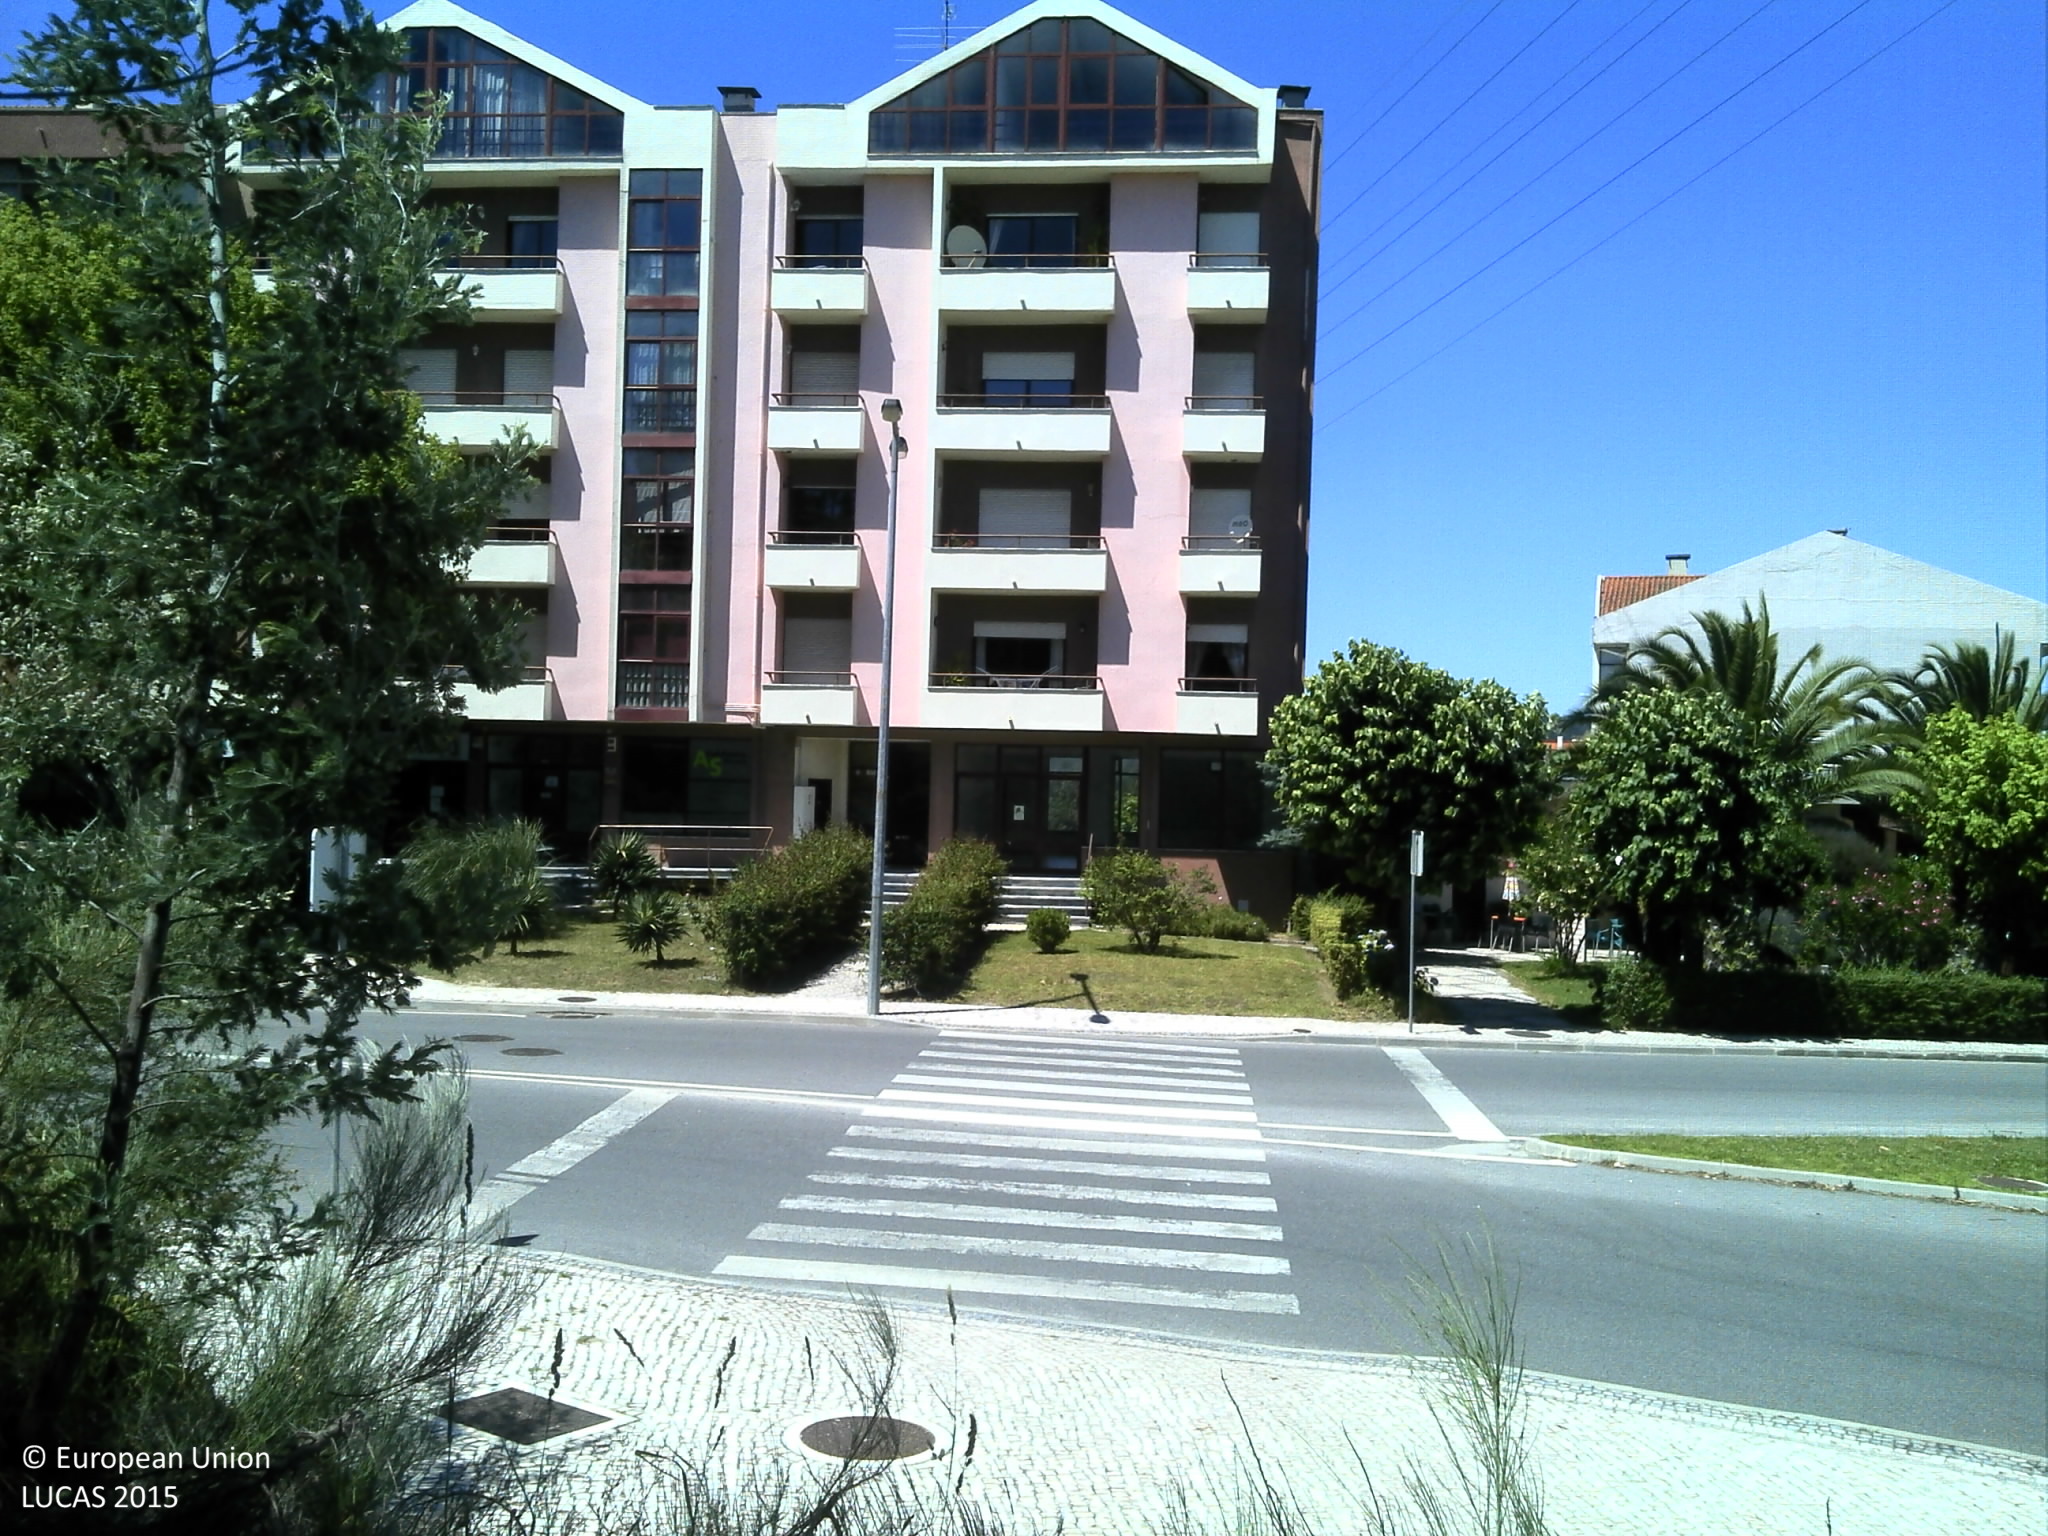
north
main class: Woodland
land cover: Broadleaved woodland
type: exotic forest
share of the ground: 50 - 75 %
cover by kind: broadleaved forest trees 70 %, shrubs 20 %, consolidated bare surface 5 %, unconsolidated bare surface 5 %
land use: Semi-natural and natural areas not in use
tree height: < 5 m
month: June
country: PT
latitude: 40.6695
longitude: -7.9286
